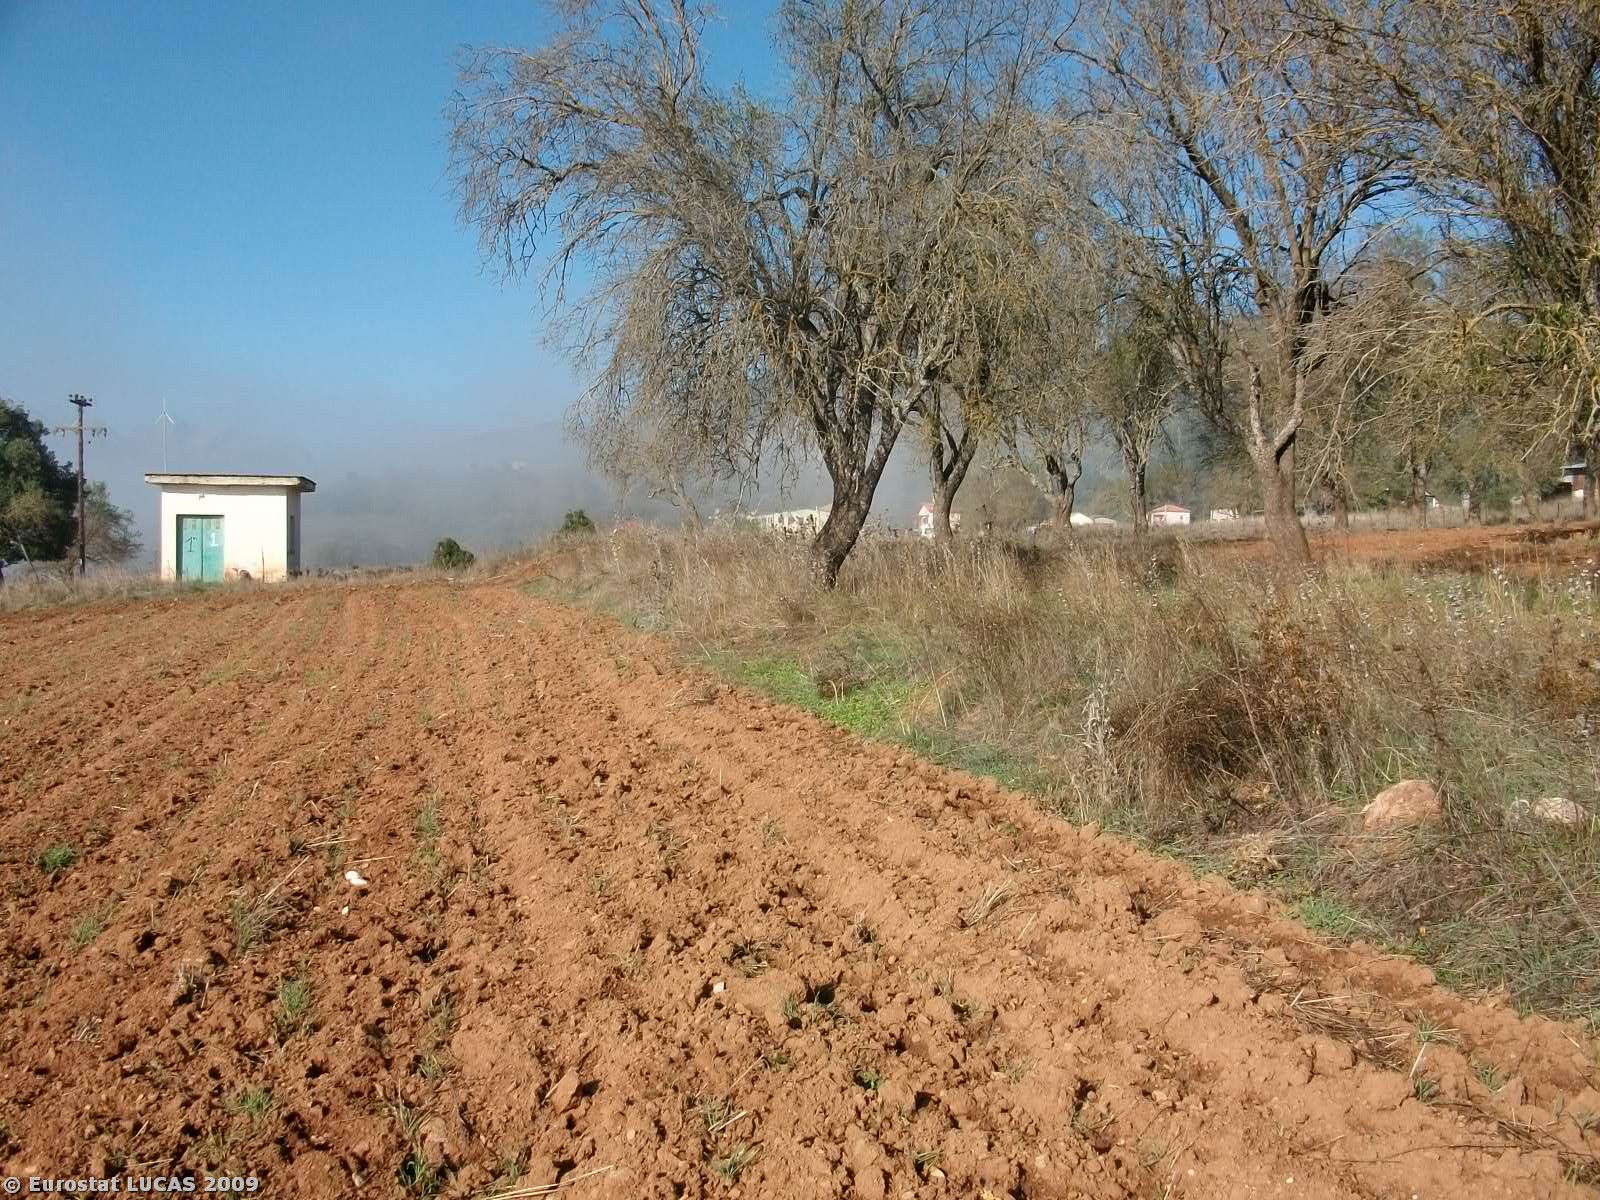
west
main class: Bare land
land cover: Bare land
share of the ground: > 75 %
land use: Fallow land
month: October
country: GR
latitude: 38.0367
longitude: 22.0784
